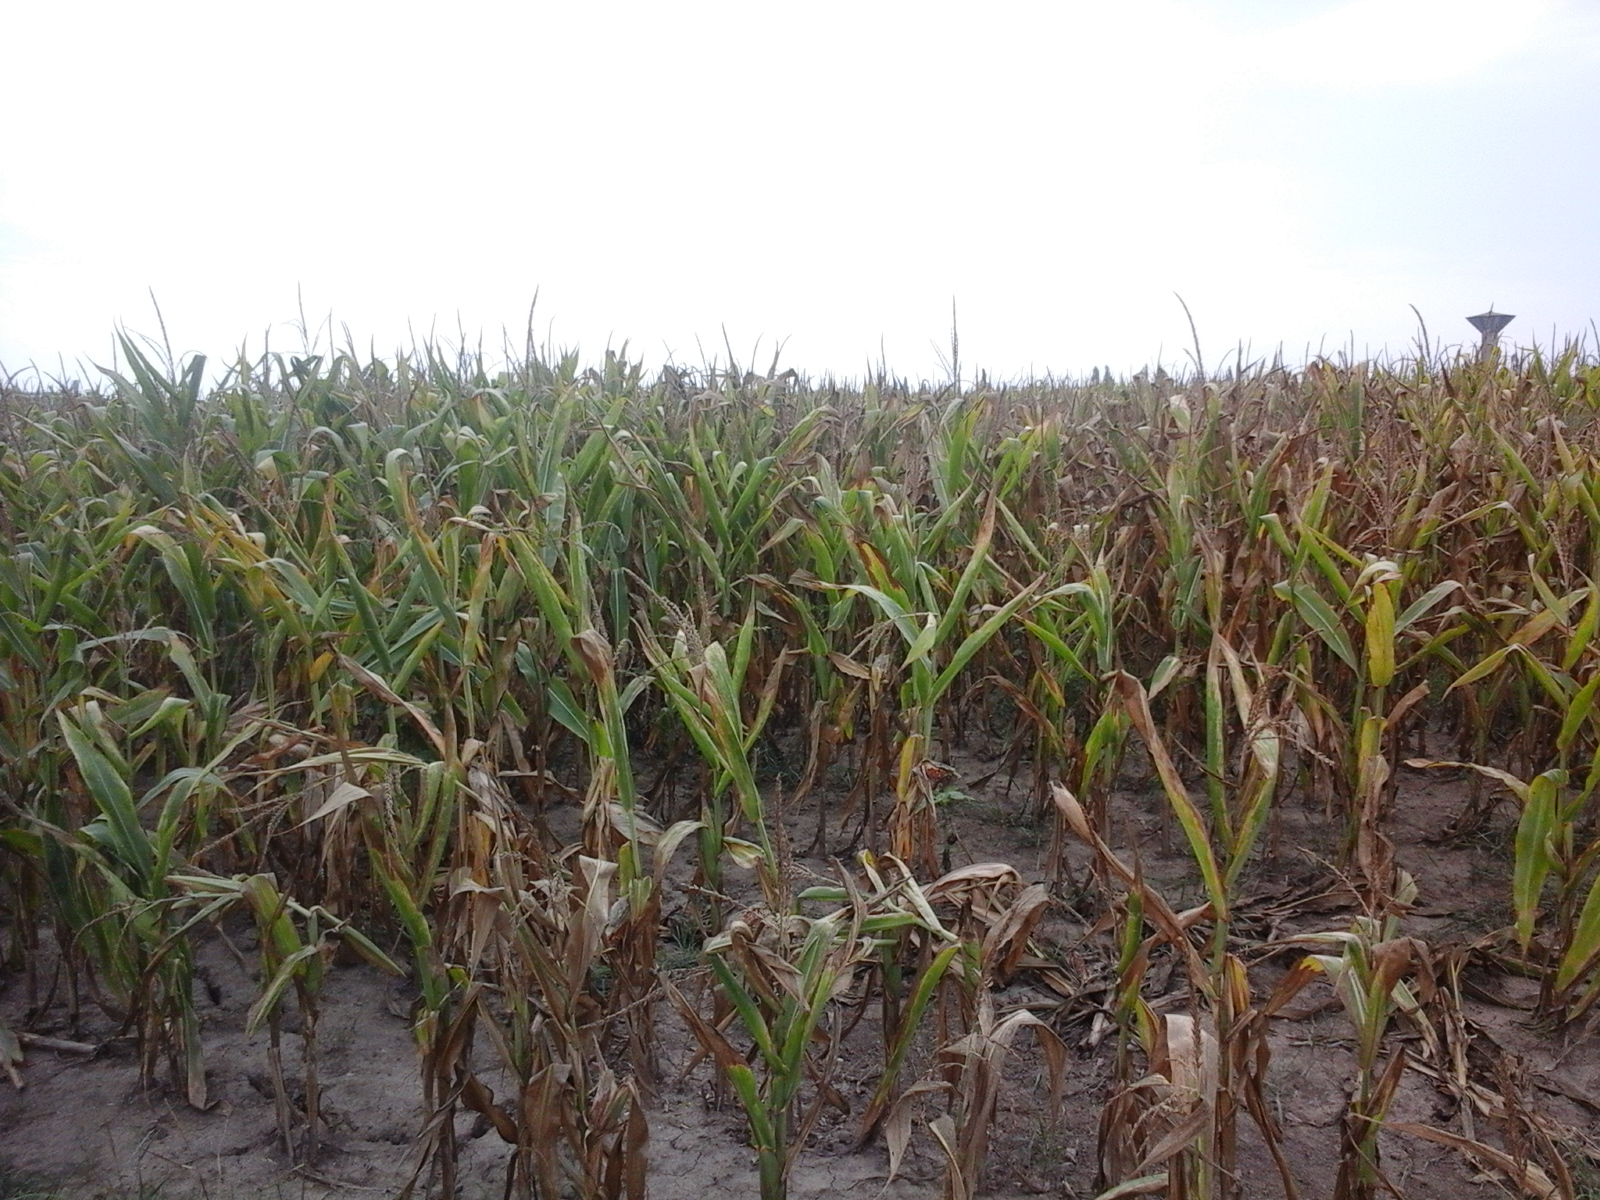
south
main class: Grassland
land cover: Grassland without tree/shrub cover
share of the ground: > 75 %
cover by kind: herbaceous plants 100 %
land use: Agriculture (excluding fallow land and kitchen gardens)
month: August
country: RO
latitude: 46.8226
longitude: 21.6418
